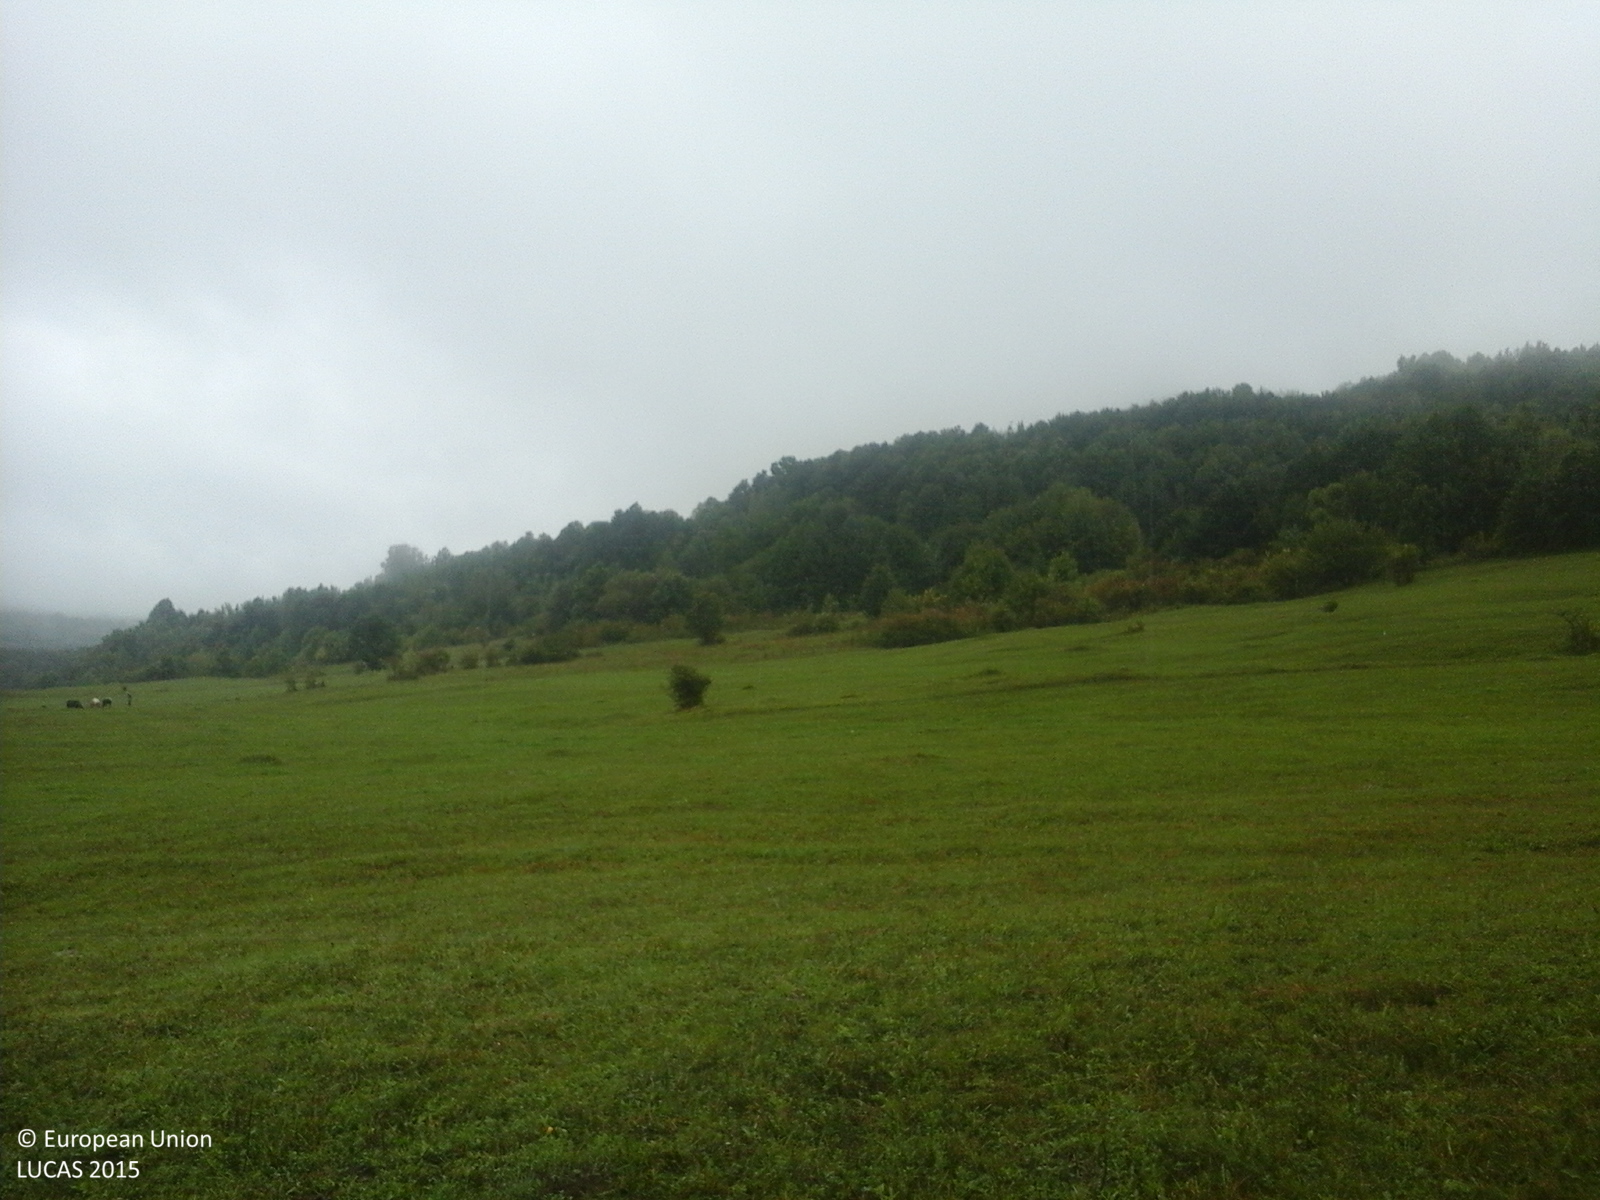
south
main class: Grassland
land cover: Grassland without tree/shrub cover
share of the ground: > 75 %
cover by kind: herbaceous plants 100 %
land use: Agriculture (excluding fallow land and kitchen gardens)
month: September
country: RO
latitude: 45.1451
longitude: 23.6307
